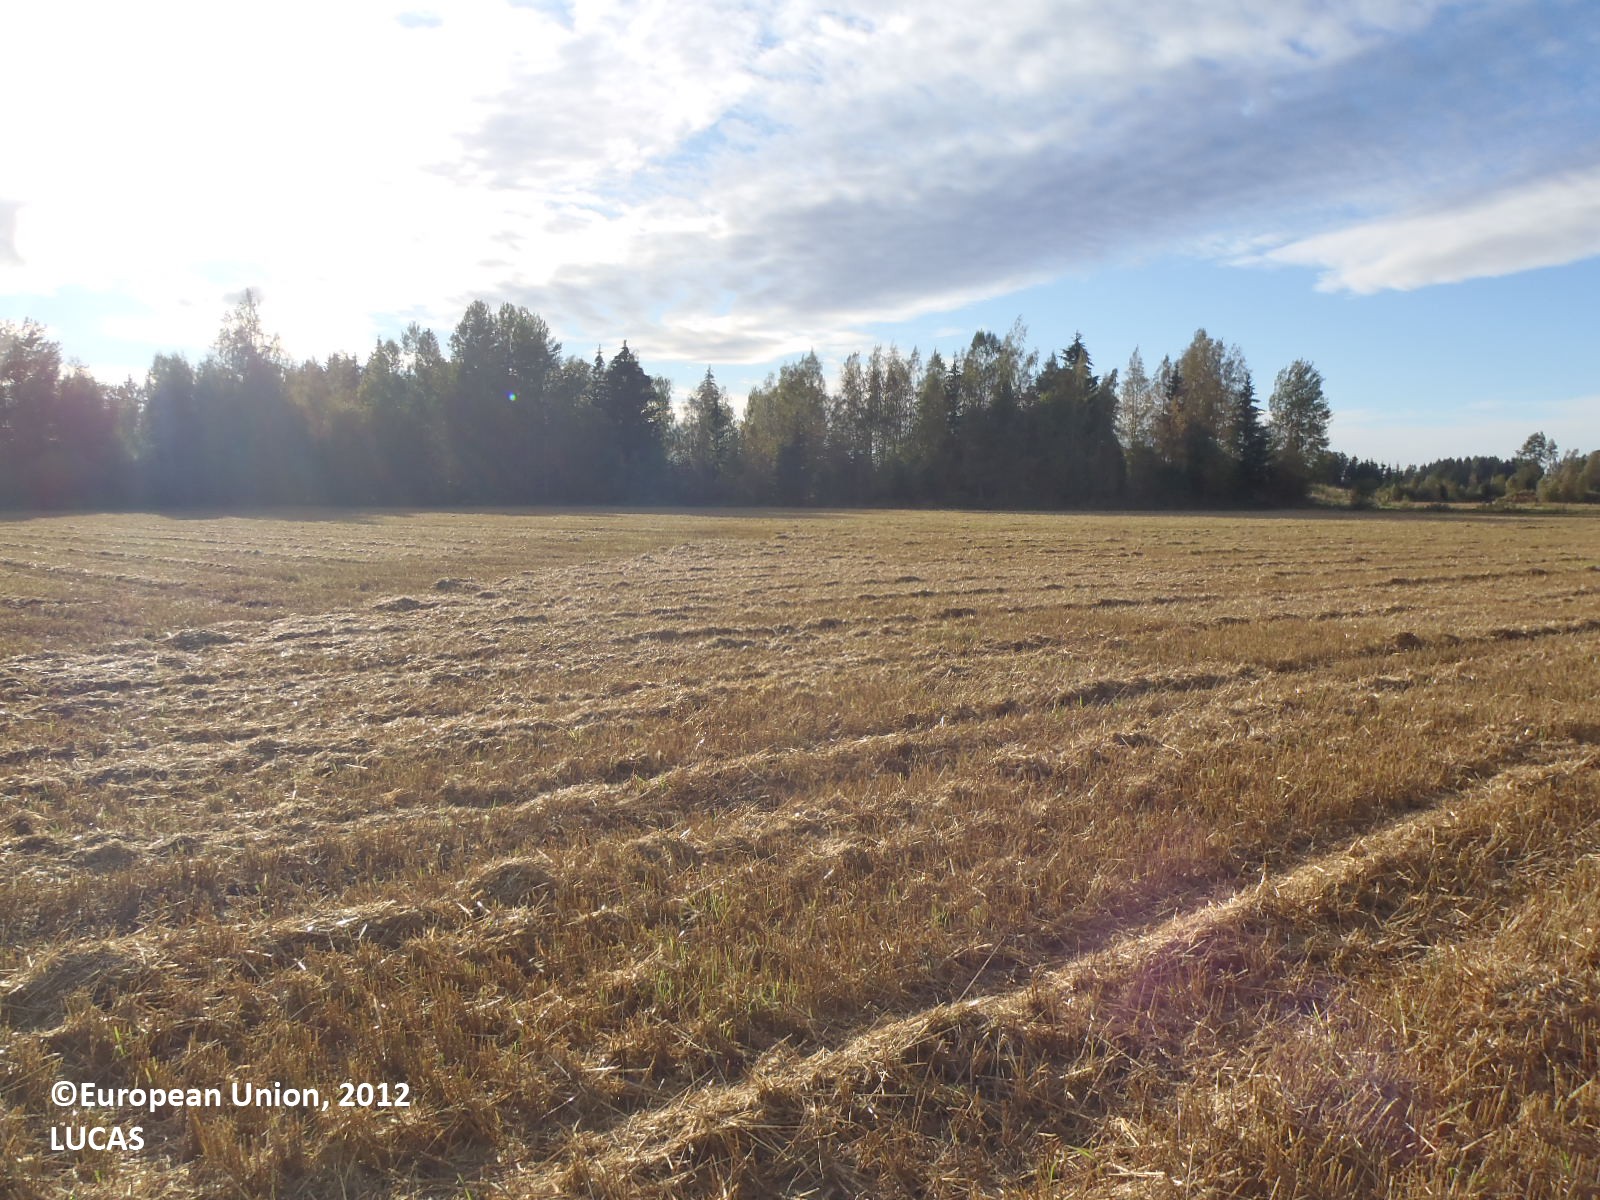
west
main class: Cropland
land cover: Barley
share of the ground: > 75 %
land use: Agriculture (excluding fallow land and kitchen gardens)
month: September
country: FI
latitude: 61.3189
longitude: 22.5235
